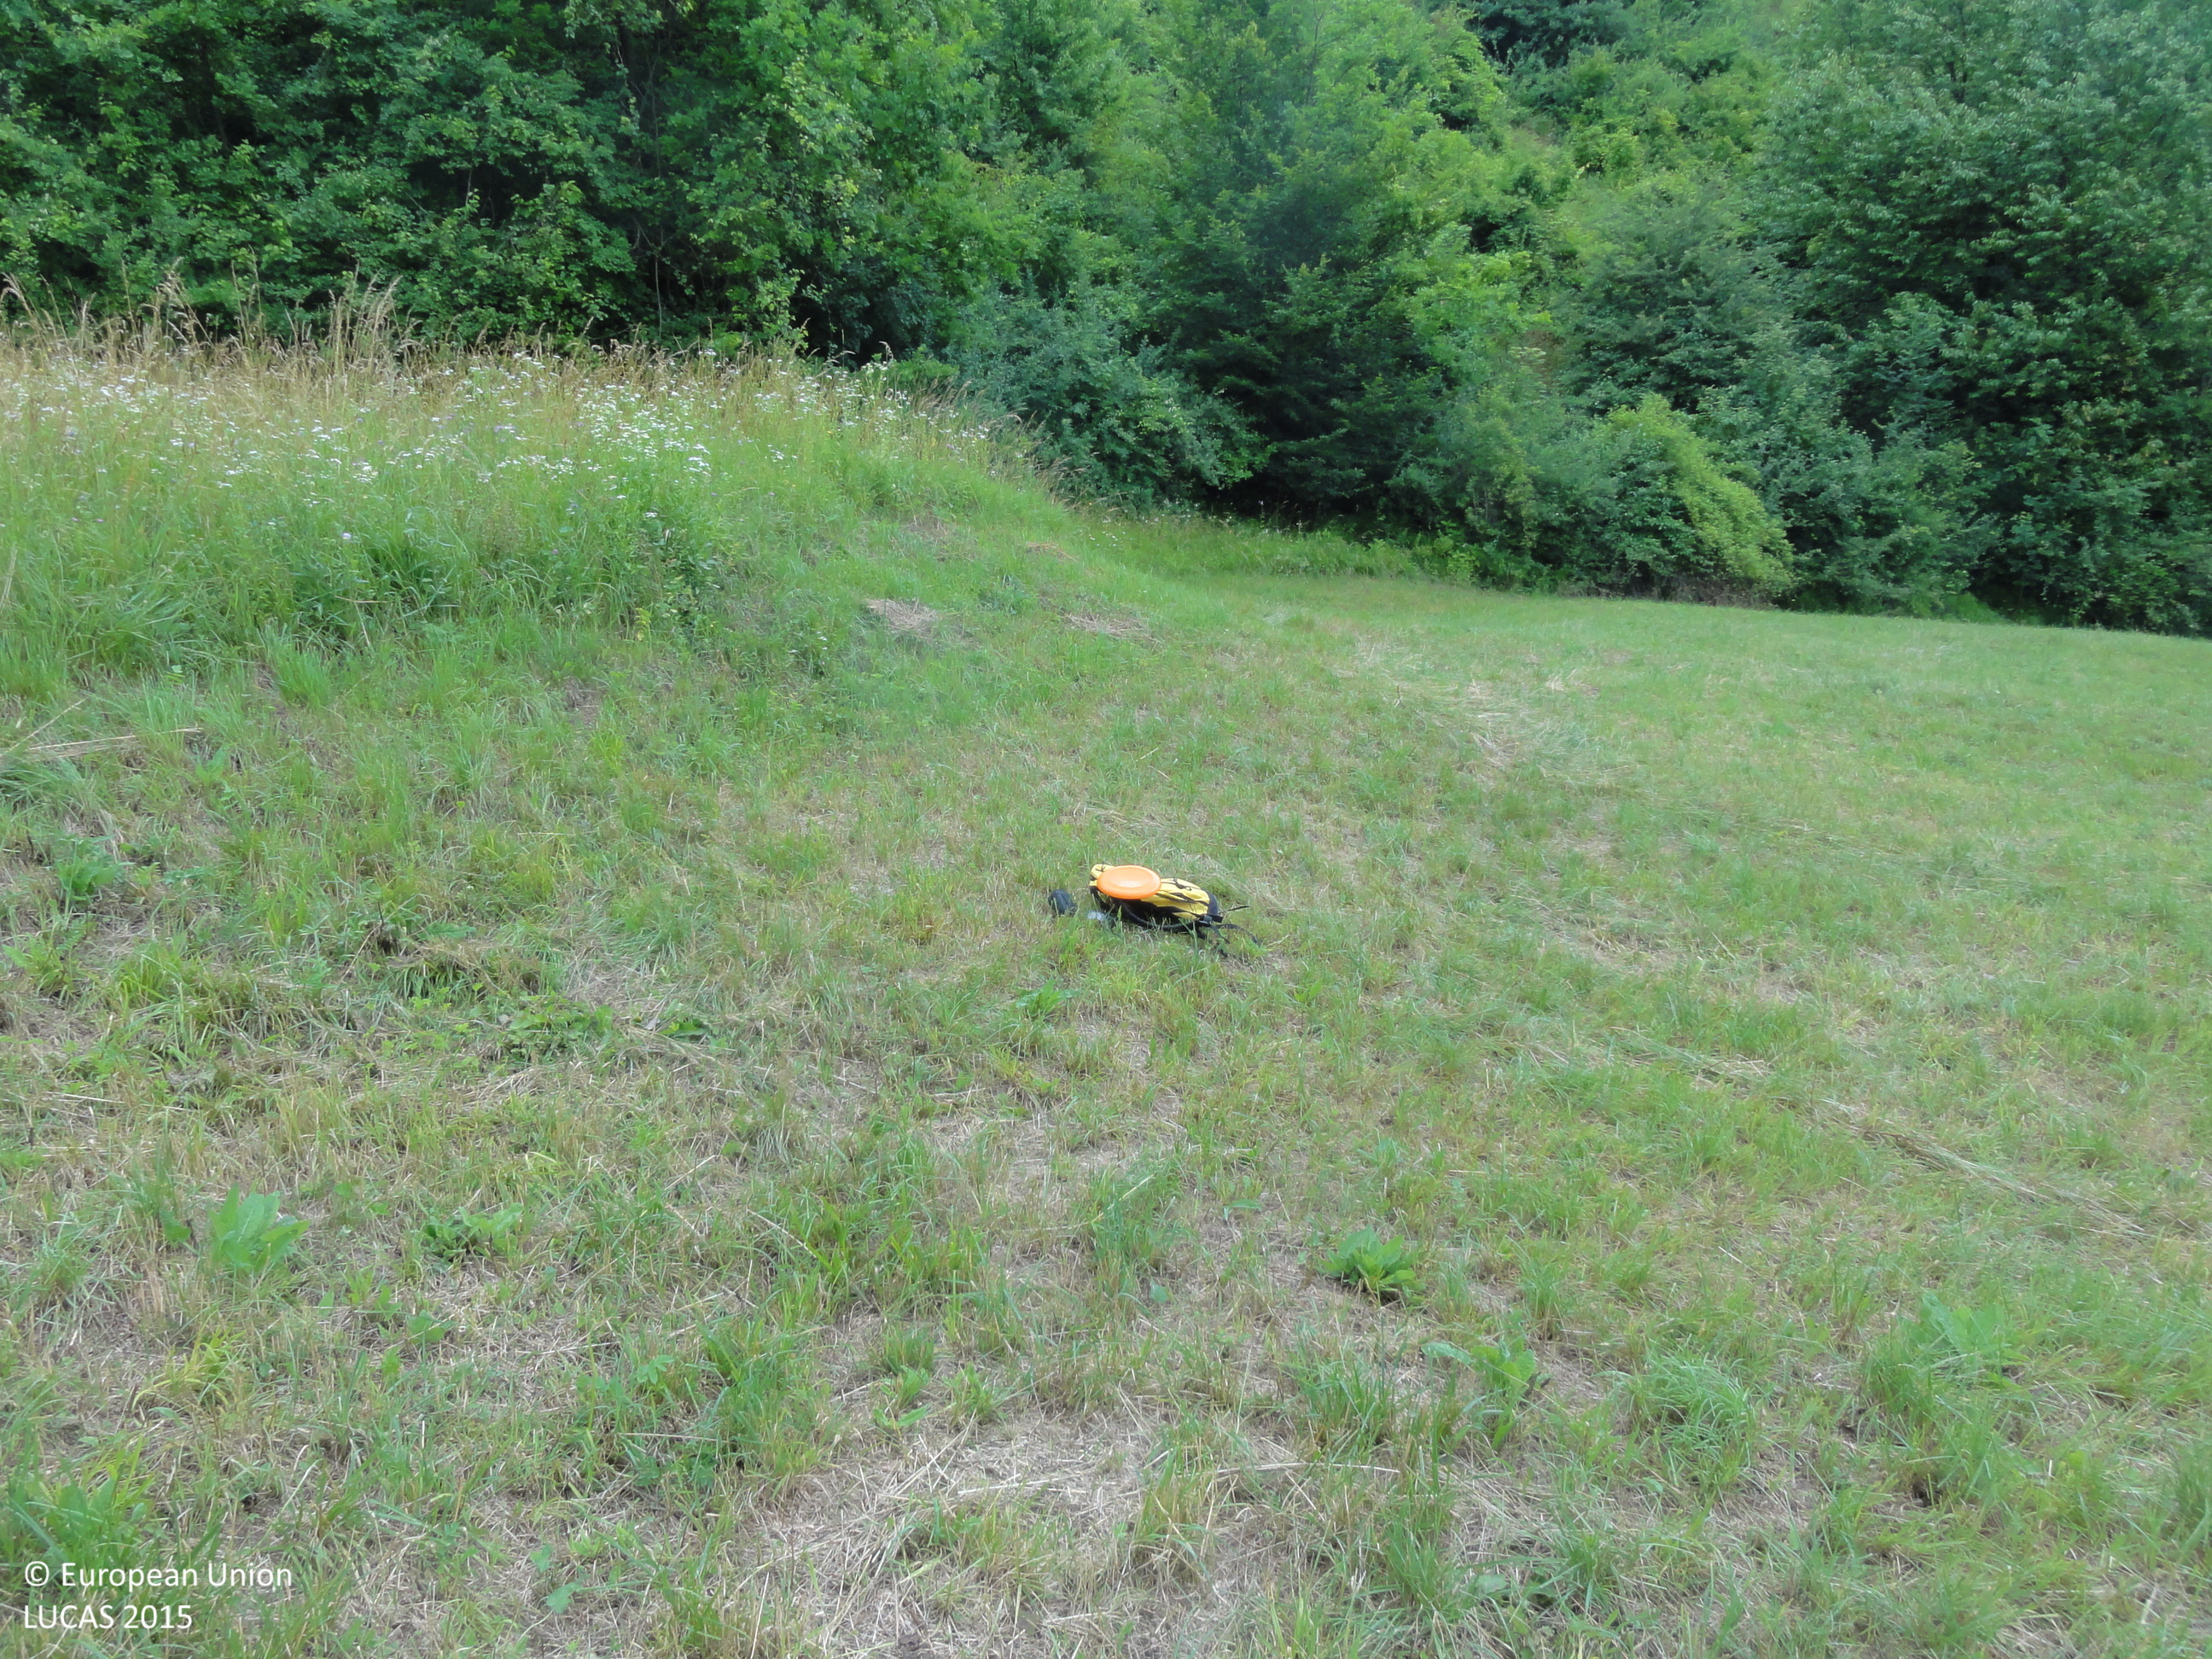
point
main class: Grassland
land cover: Grassland without tree/shrub cover
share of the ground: > 75 %
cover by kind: herbaceous plants 100 %
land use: Agriculture (excluding fallow land and kitchen gardens)
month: June
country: SI
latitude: 46.6582
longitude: 15.5531
